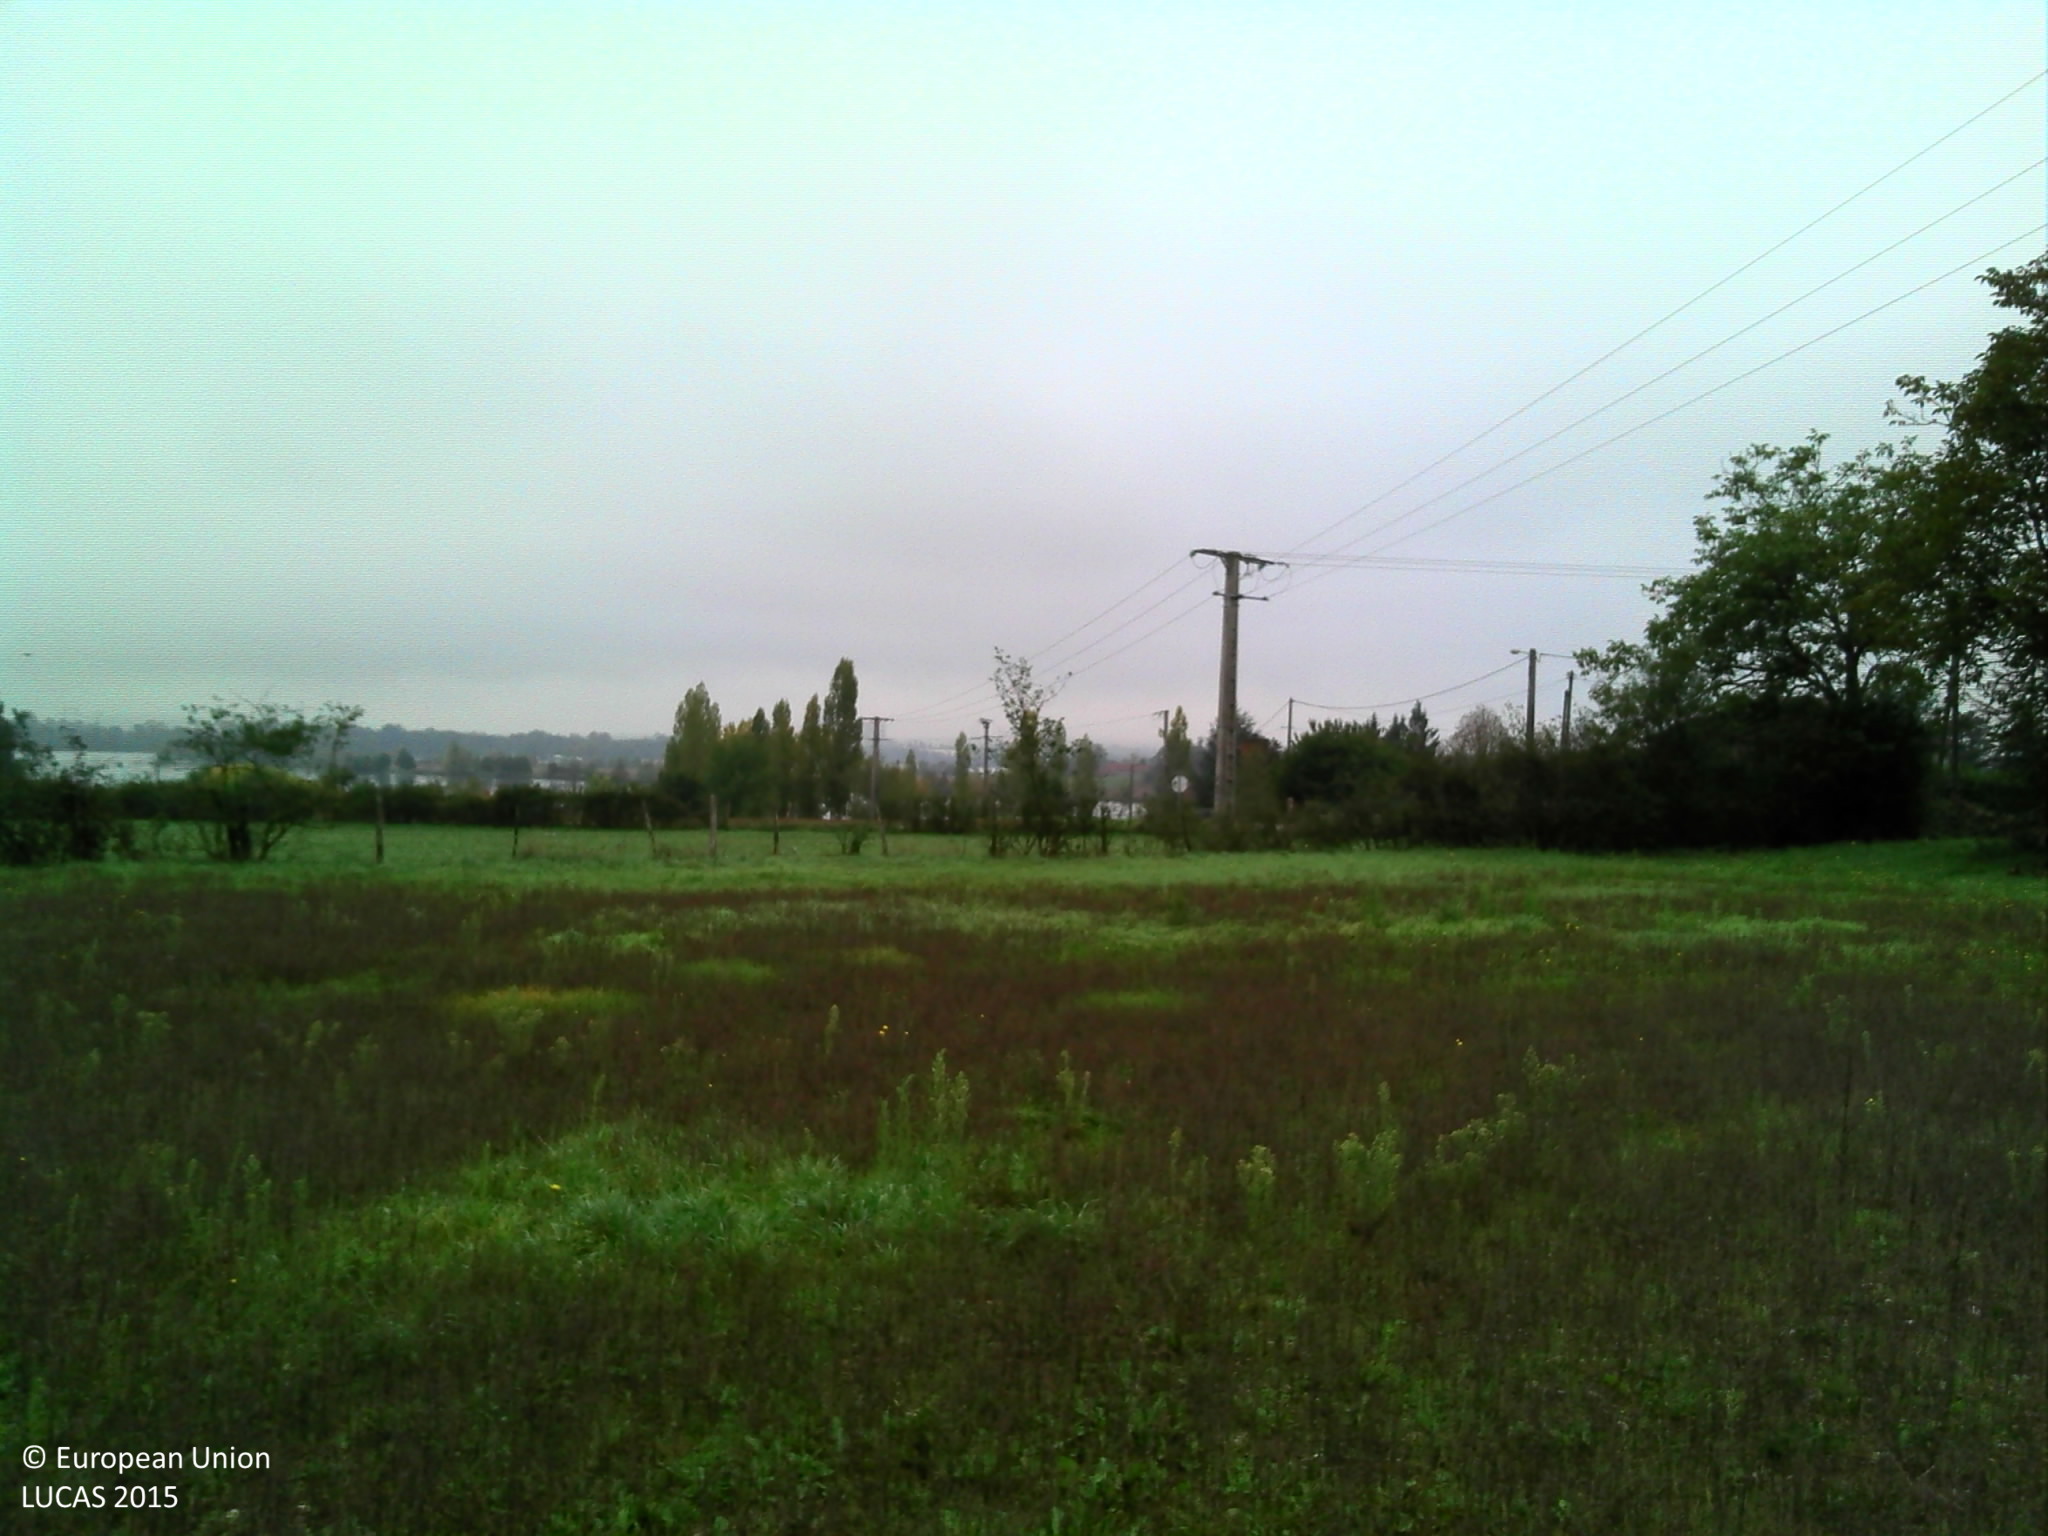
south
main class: Grassland
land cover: Spontaneously vegetated surfaces
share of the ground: > 75 %
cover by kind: herbaceous plants 100 %
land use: Agriculture (excluding fallow land and kitchen gardens)
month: October
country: FR
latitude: 45.8387
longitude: 5.4332
